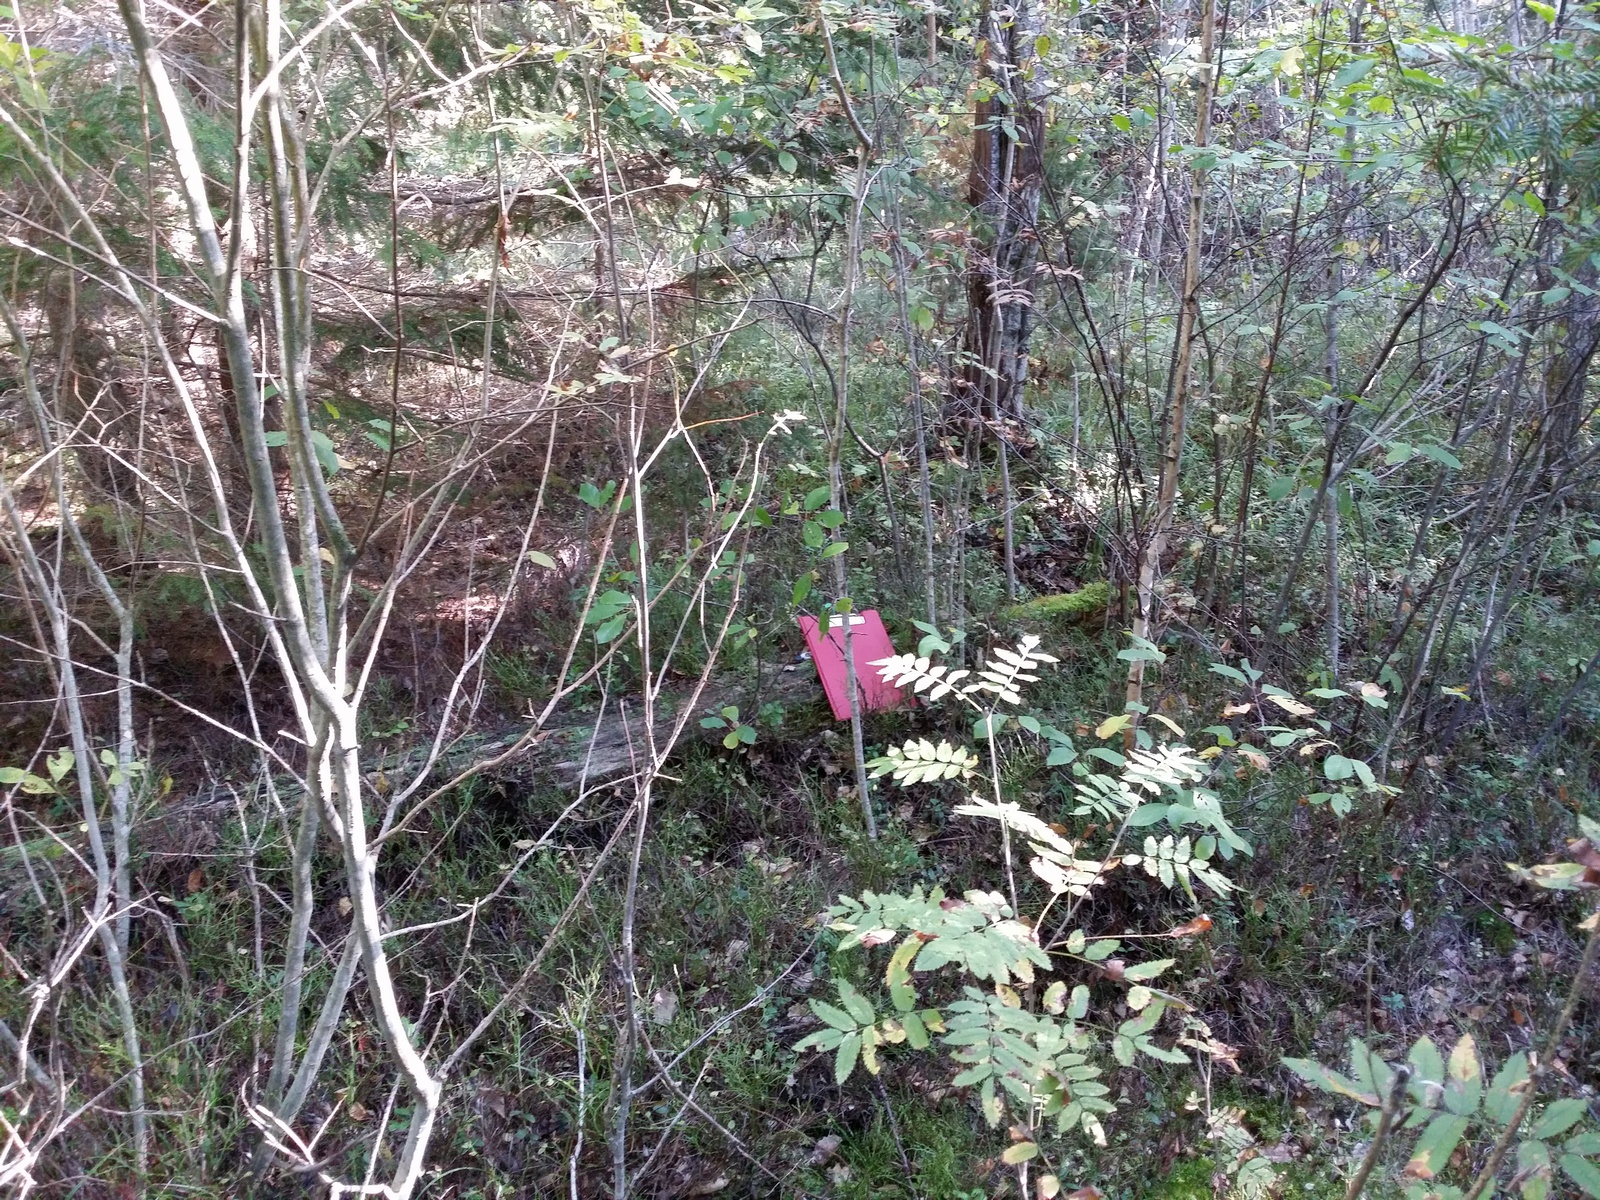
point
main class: Woodland
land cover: Spruce dominated mixed woodland
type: hemiboreal forest and nemoral coniferous forest and mixed broadleaved-coniferous forest
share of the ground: > 75 %
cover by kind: coniferous forest trees 50 %, broadleaved forest trees 35 %, lichens and mosses 10 %, herbaceous plants 5 %
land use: Forestry
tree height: > 5 m
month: September
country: LV
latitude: 57.1905
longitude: 27.6035
